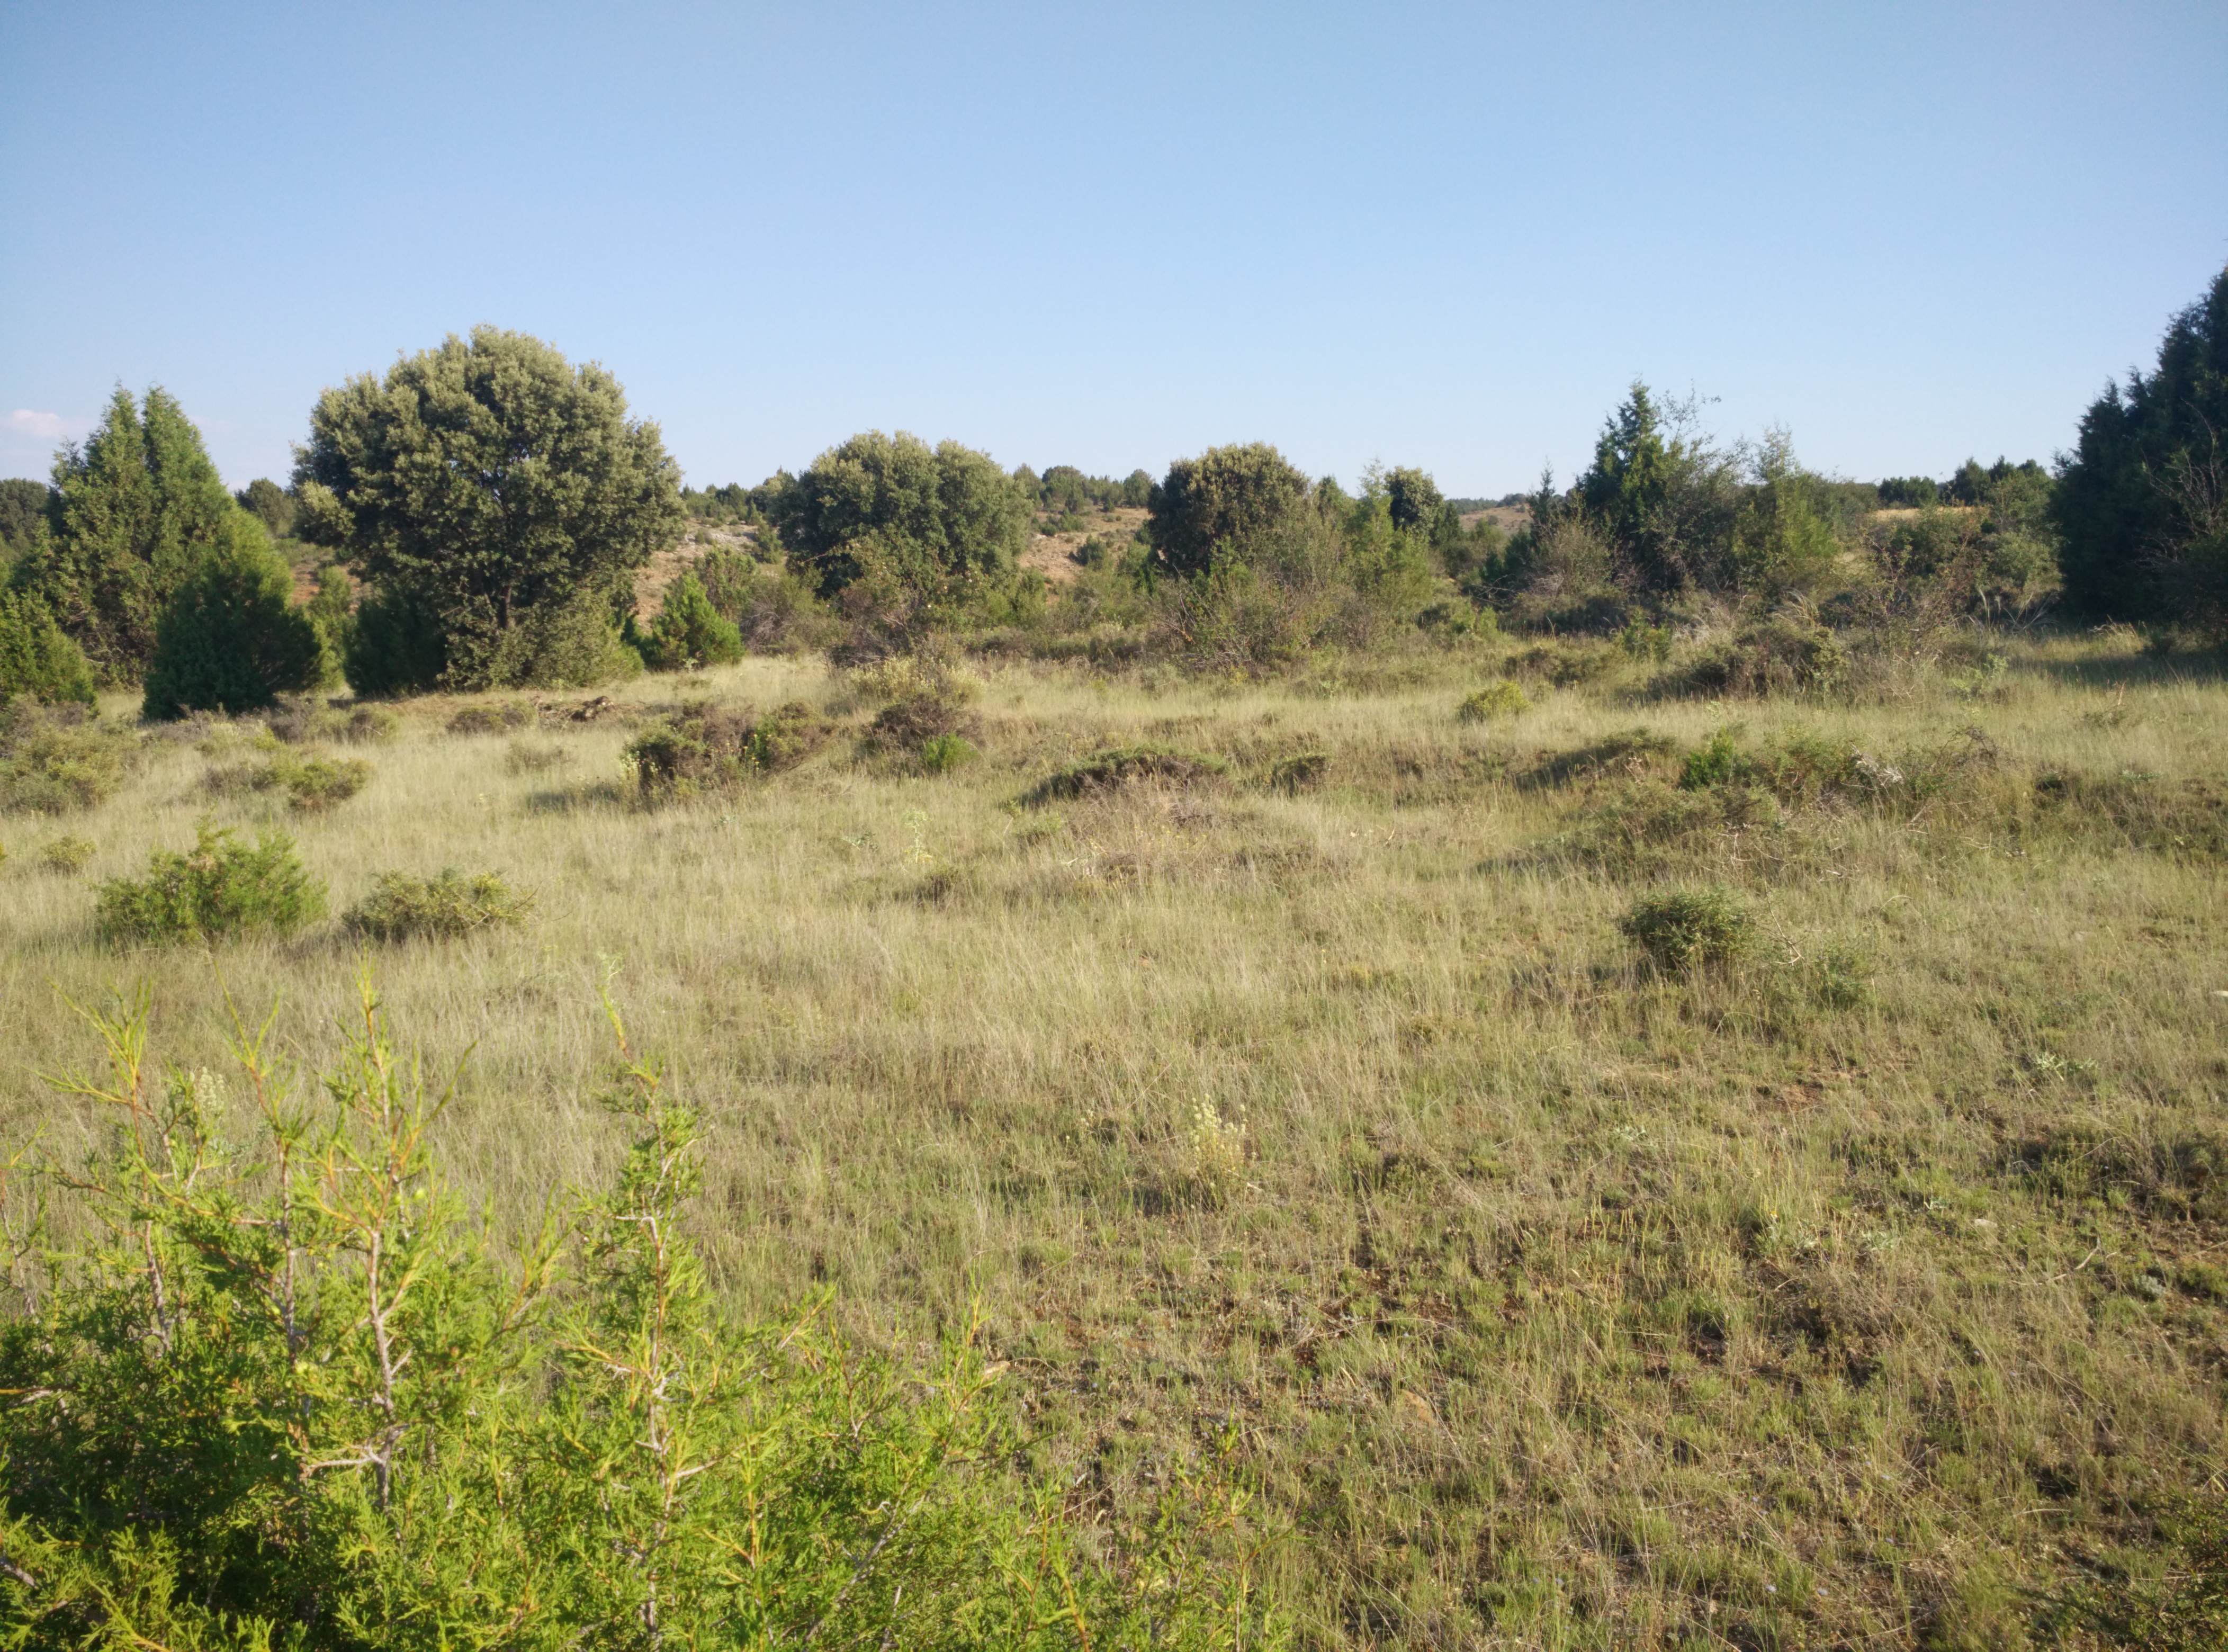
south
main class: Grassland
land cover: Grassland with sparse tree/shrub cover
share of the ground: 25 - 50 %
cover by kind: unconsolidated bare surface 50 %, herbaceous plants 40 %, broadleaved forest trees 5 %, shrubs 5 %
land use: Semi-natural and natural areas not in use
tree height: < 5 m
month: June
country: ES
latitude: 40.7391
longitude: -1.8030
